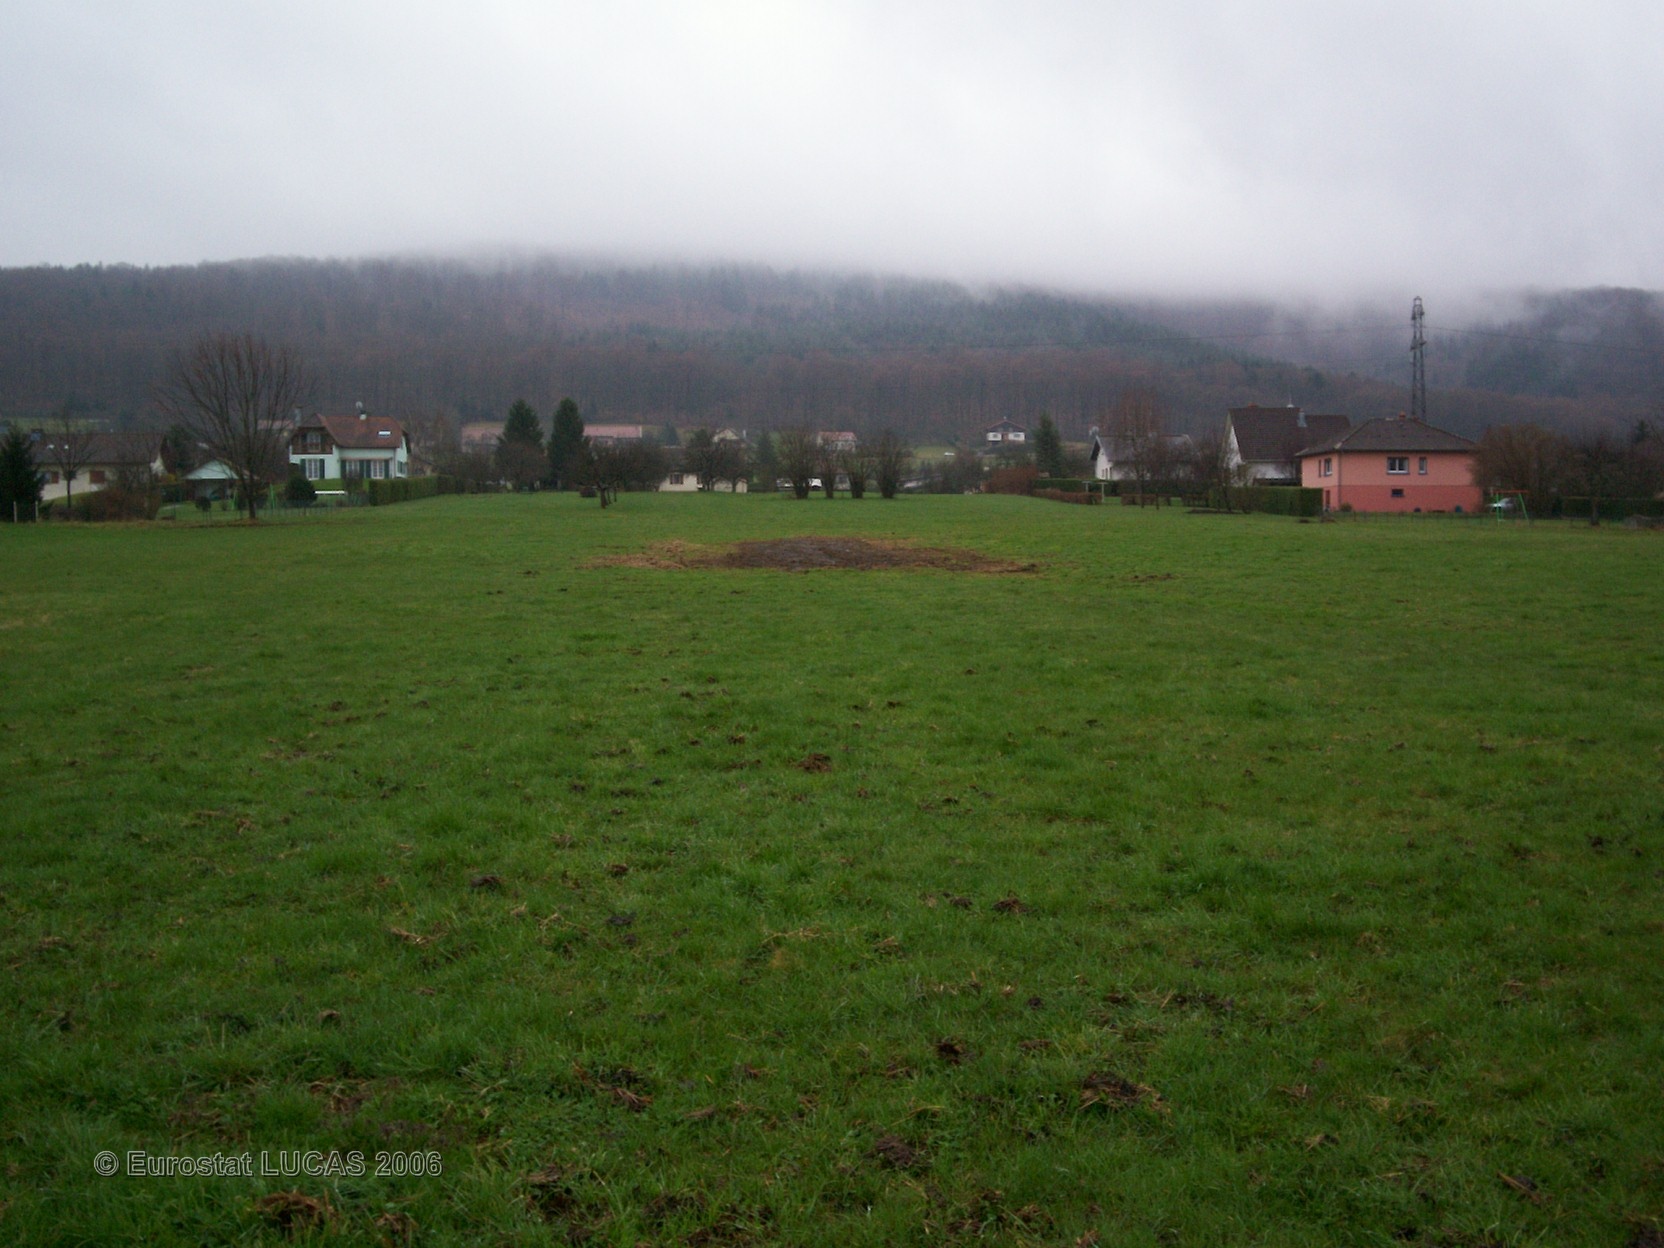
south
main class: Grassland
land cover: Grassland without tree/shrub cover
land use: Agriculture (excluding fallow land and kitchen gardens)
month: April
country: FR
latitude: 47.6734
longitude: 6.8183
